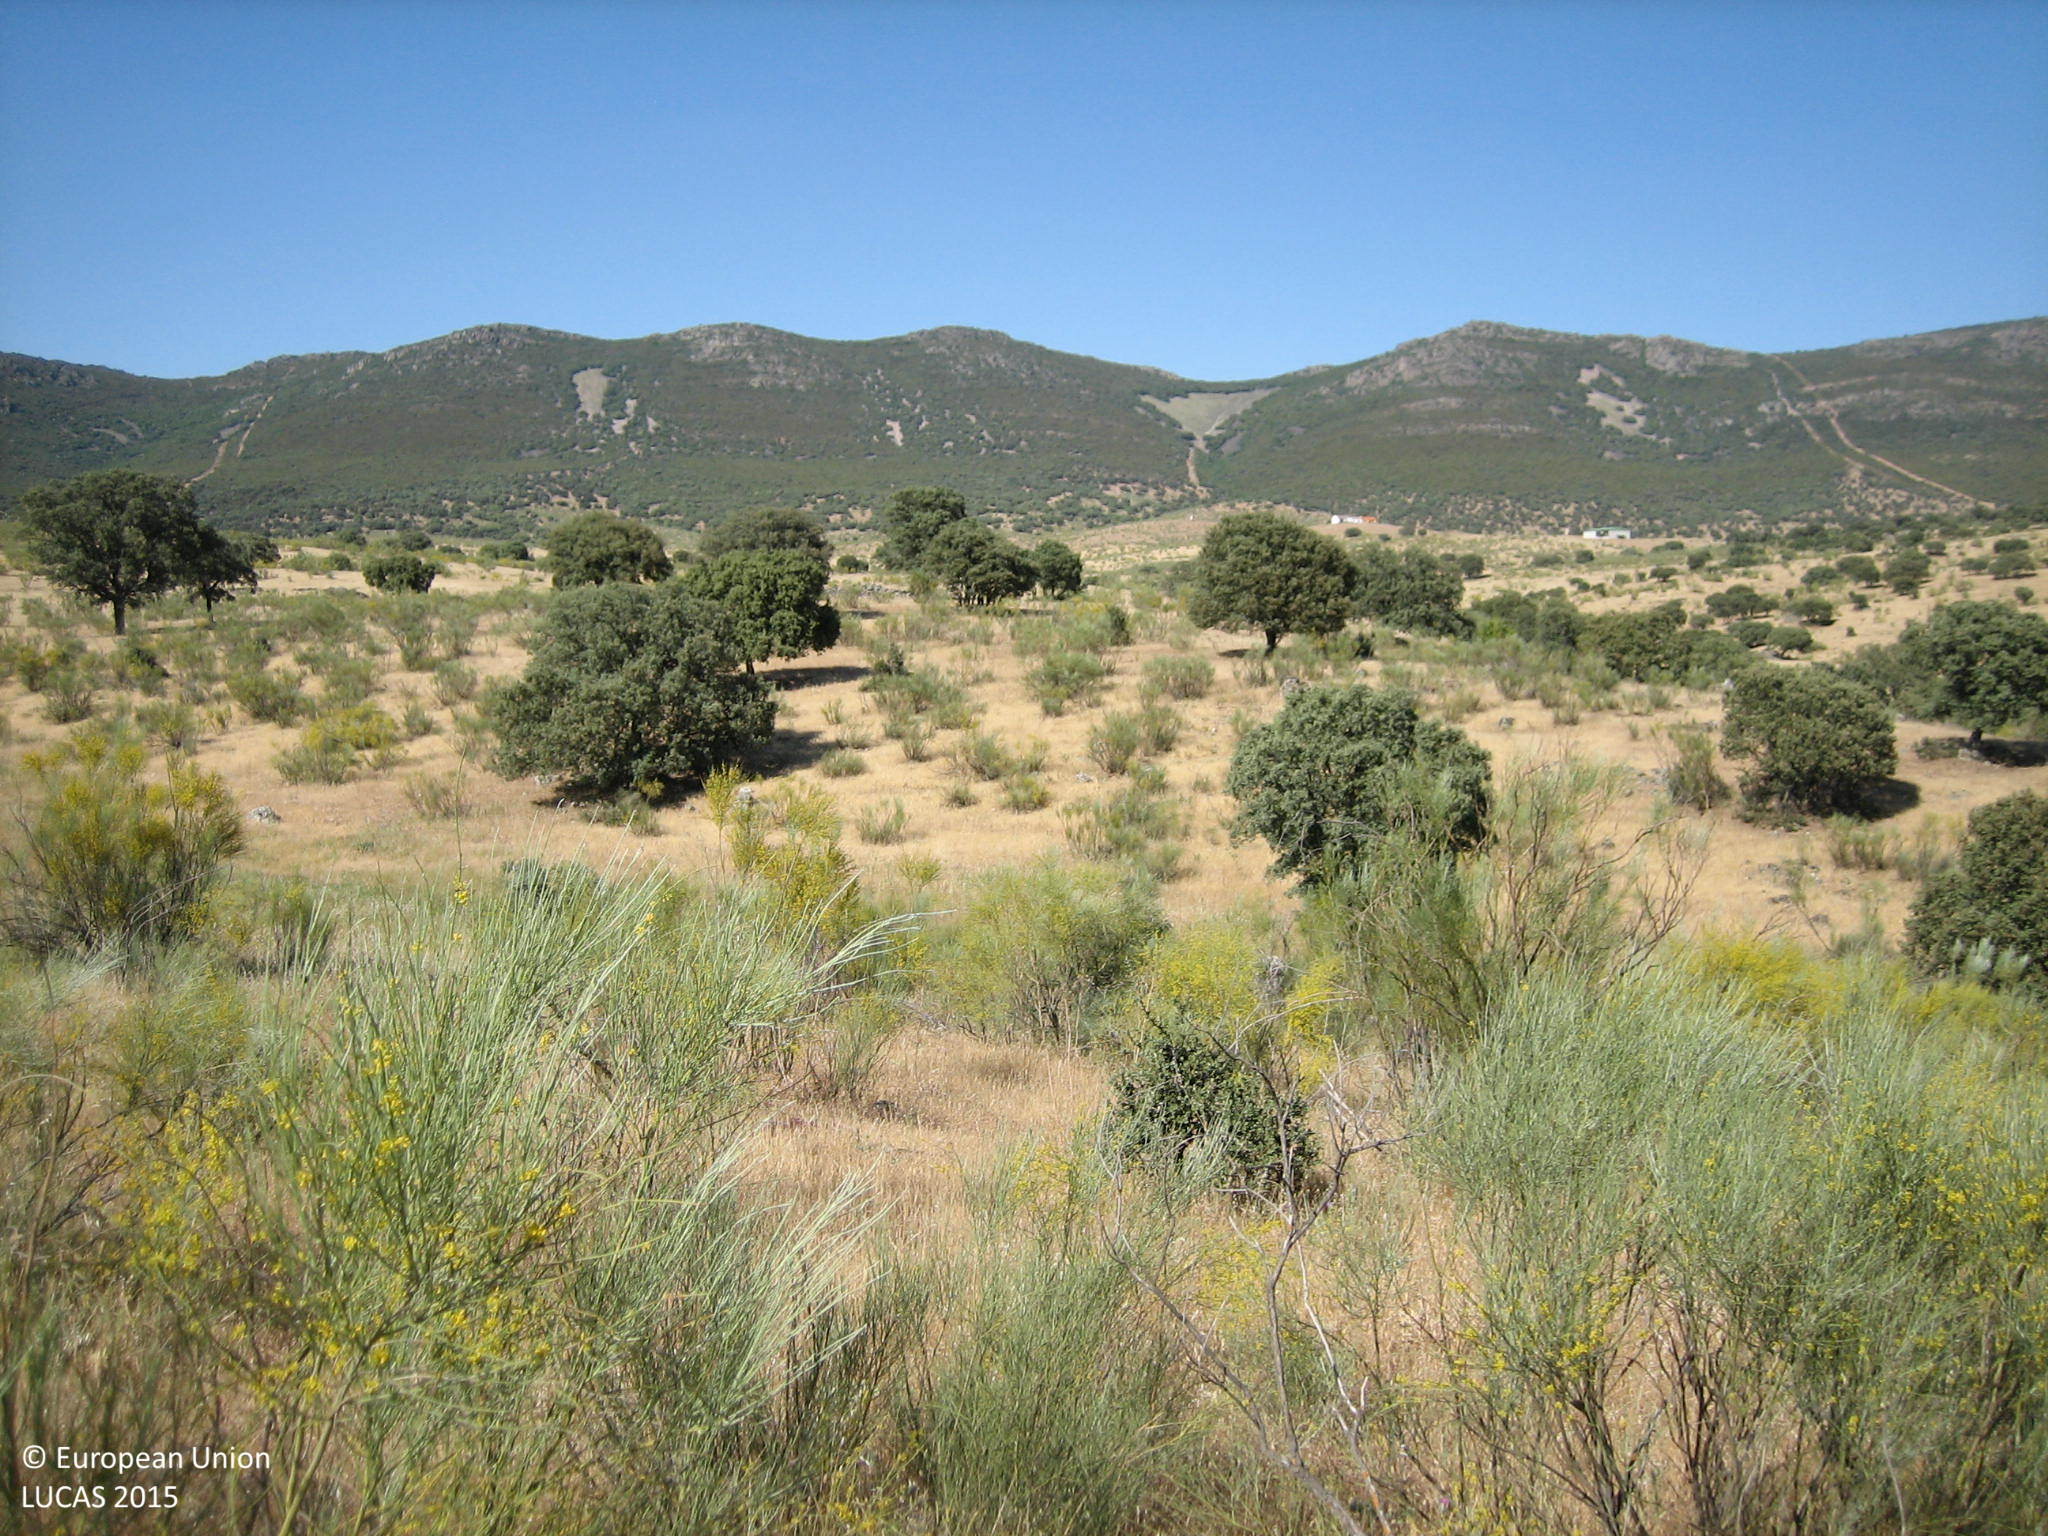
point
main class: Grassland
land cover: Grassland with sparse tree/shrub cover
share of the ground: > 75 %
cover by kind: herbaceous plants 90 %, broadleaved forest trees 5 %, shrubs 5 %
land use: Agriculture (excluding fallow land and kitchen gardens)
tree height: > 5 m
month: May
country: ES
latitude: 38.5459
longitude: -3.9780
